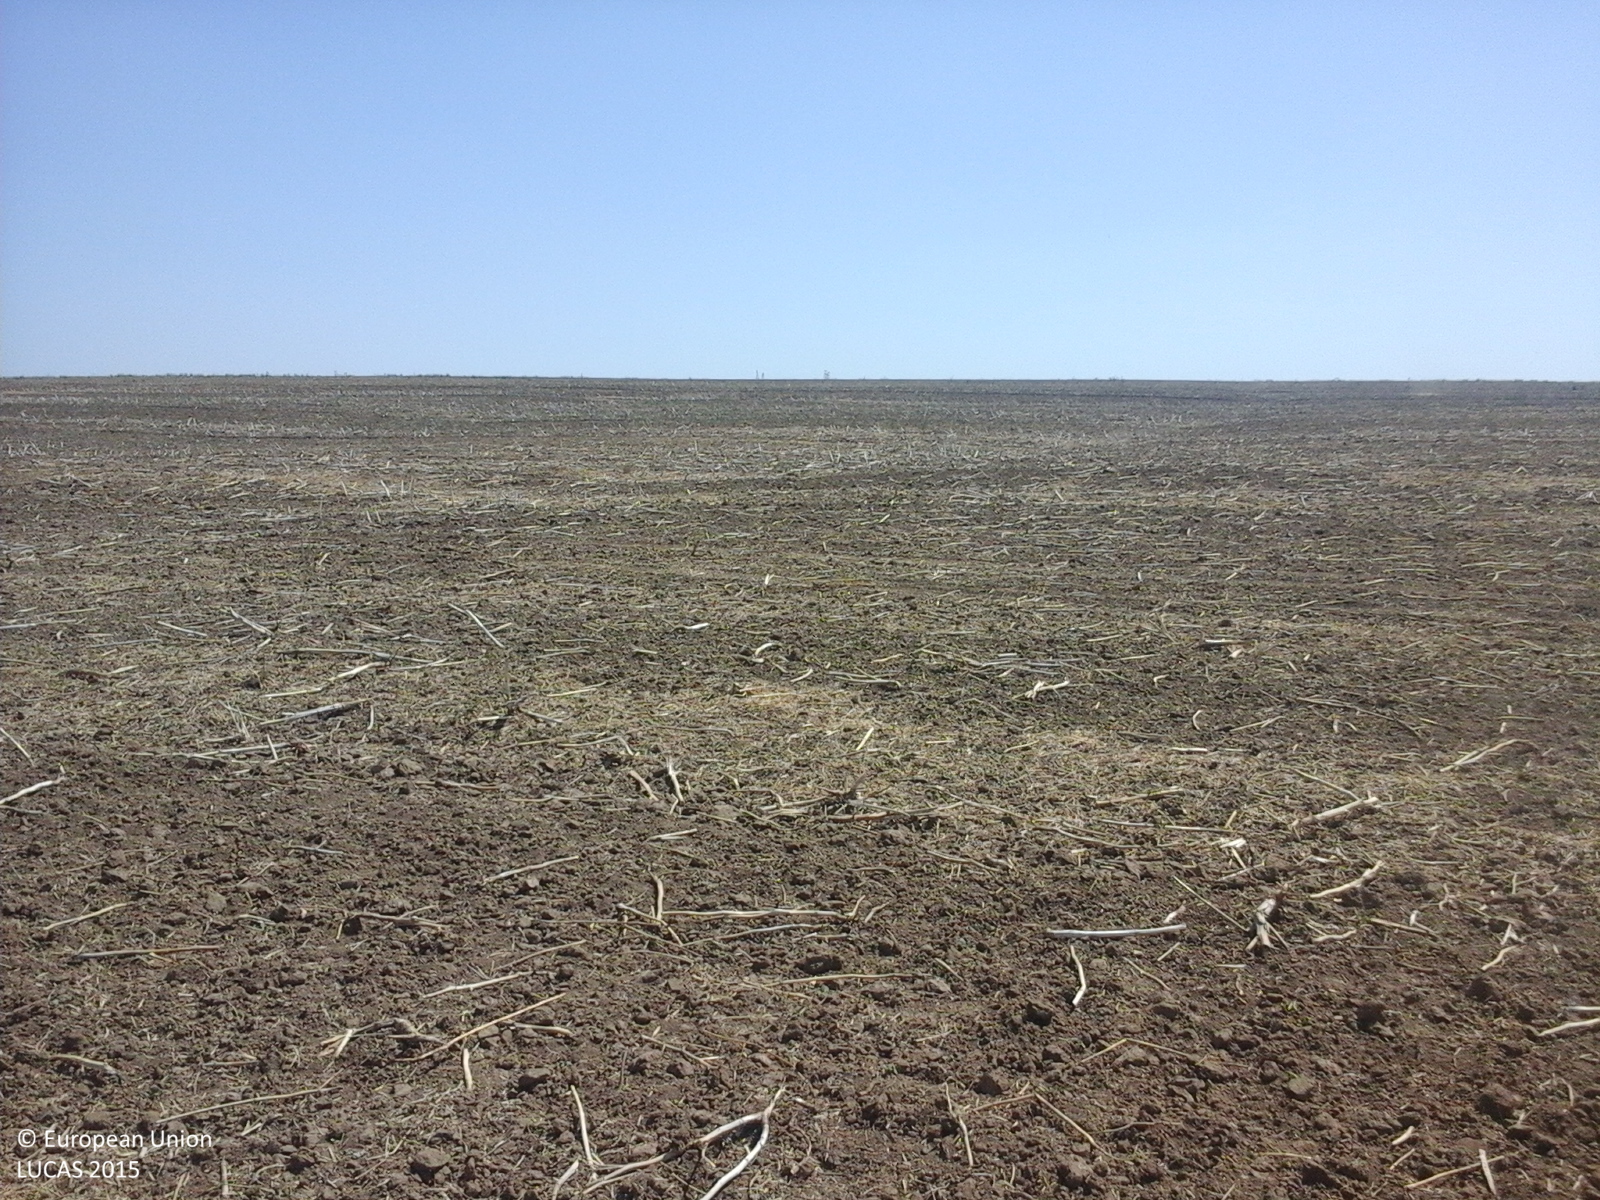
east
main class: Cropland
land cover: Rape and turnip rape
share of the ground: < 10 %
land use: Agriculture (excluding fallow land and kitchen gardens)
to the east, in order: Rape and turnip rape
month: August
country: RO
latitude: 44.5898
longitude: 28.1902
